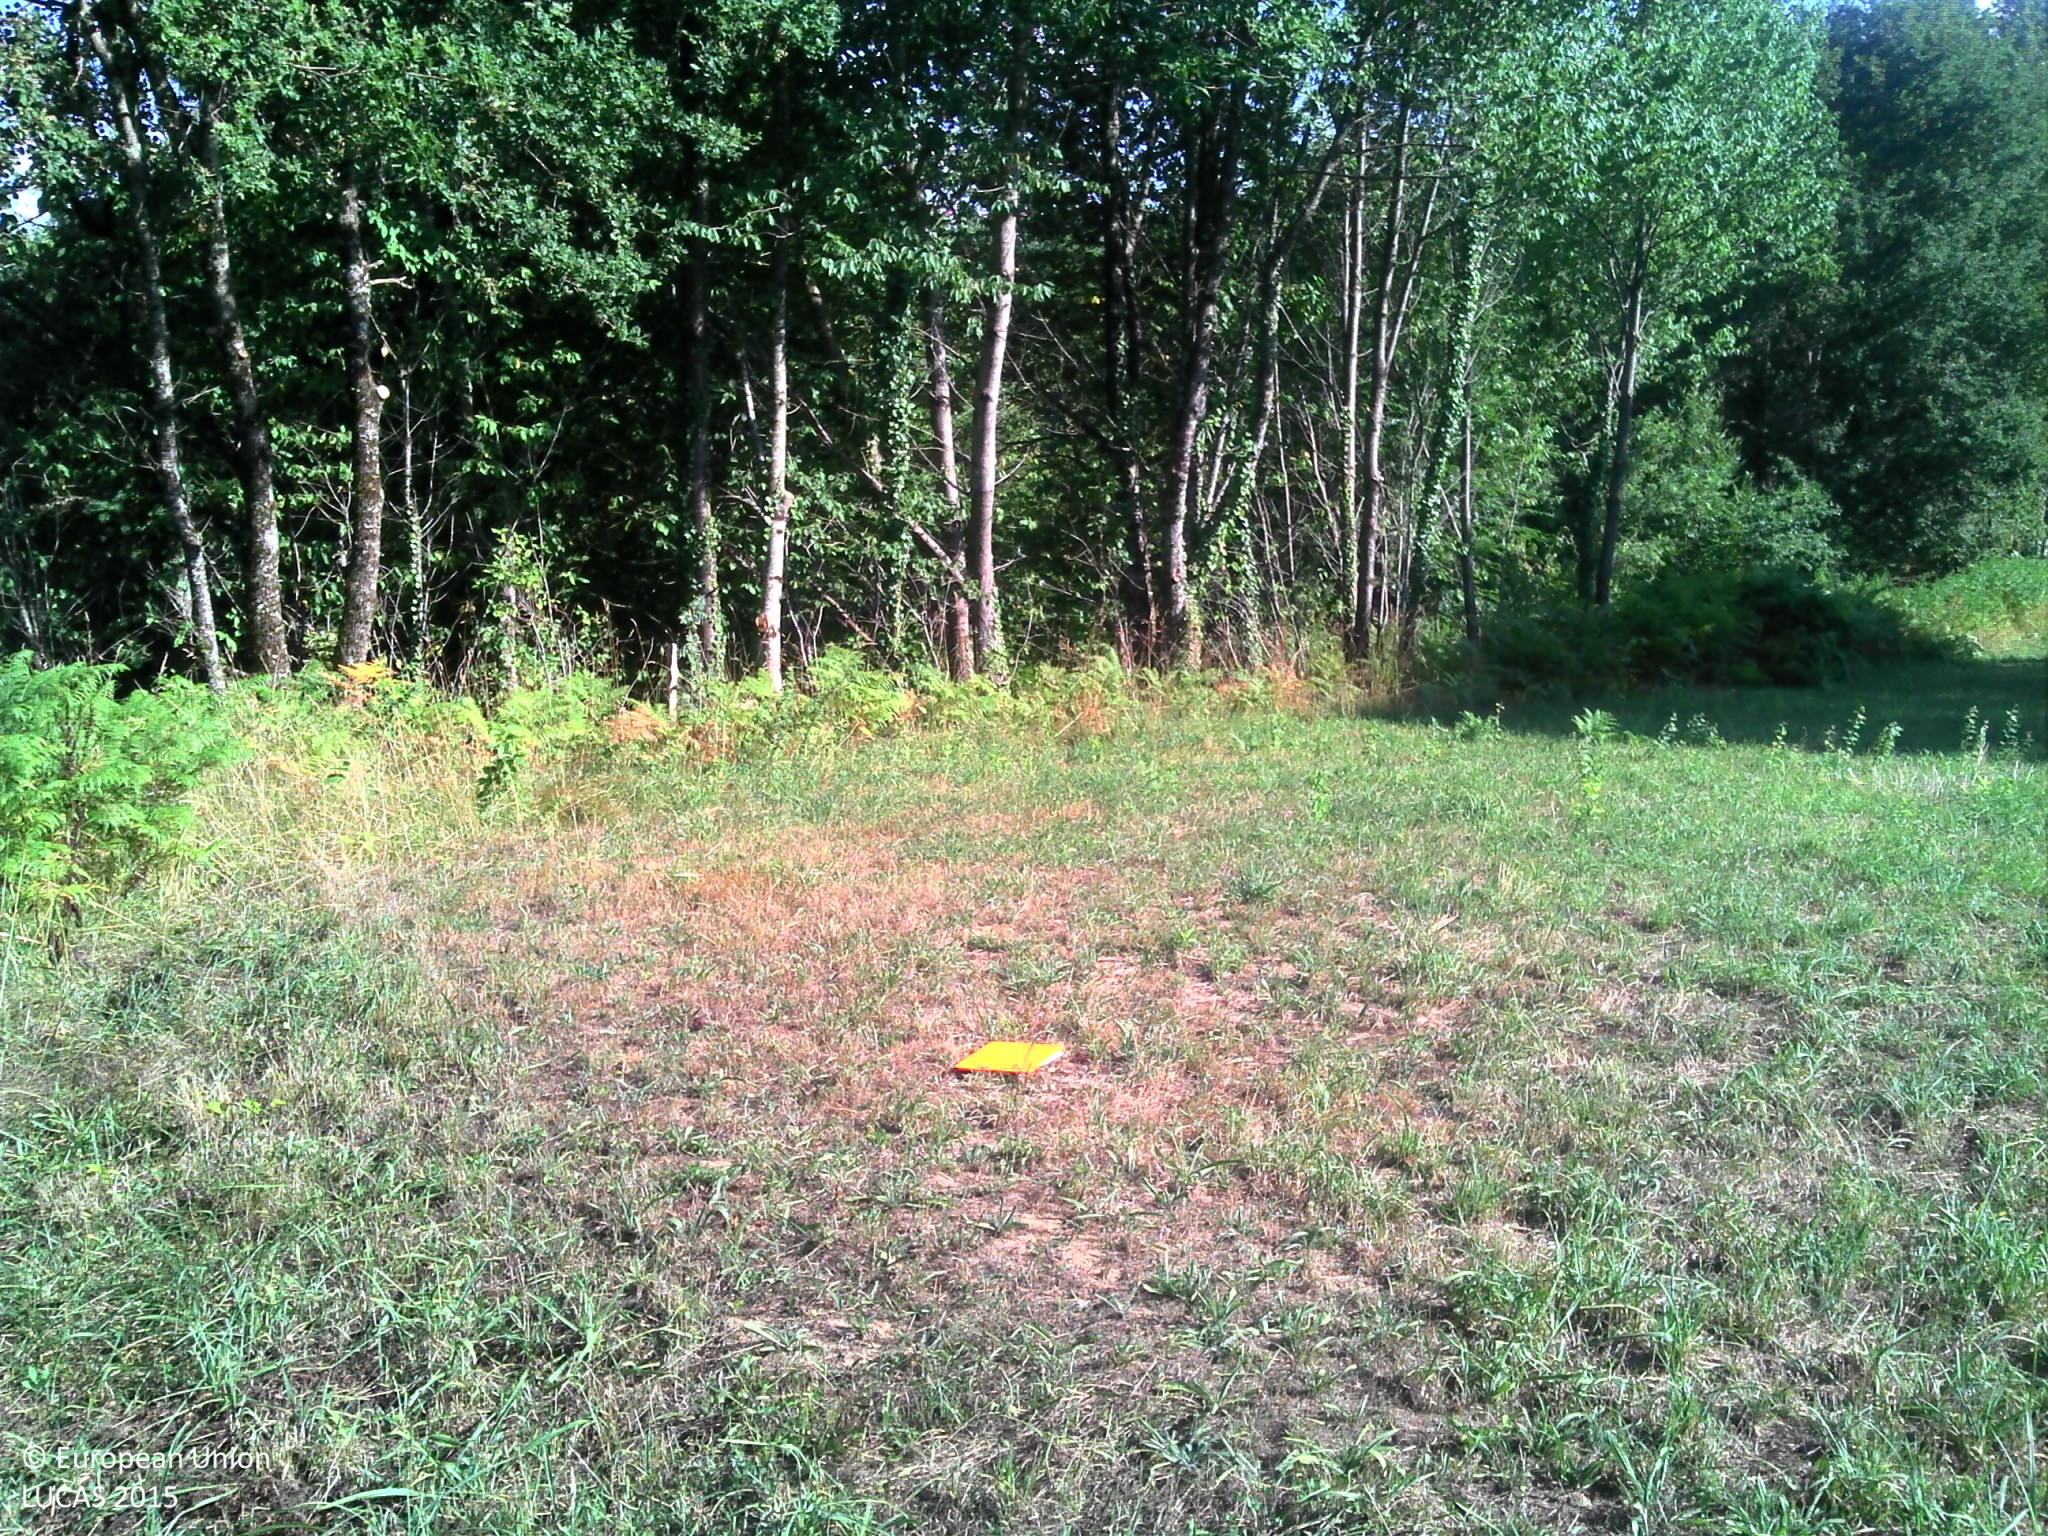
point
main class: Grassland
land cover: Grassland with sparse tree/shrub cover
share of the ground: > 75 %
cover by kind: herbaceous plants 85 %, shrubs 10 %, broadleaved forest trees 5 %
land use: Agriculture (excluding fallow land and kitchen gardens)
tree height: > 5 m
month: August
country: FR
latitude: 45.2497
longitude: 1.7012
